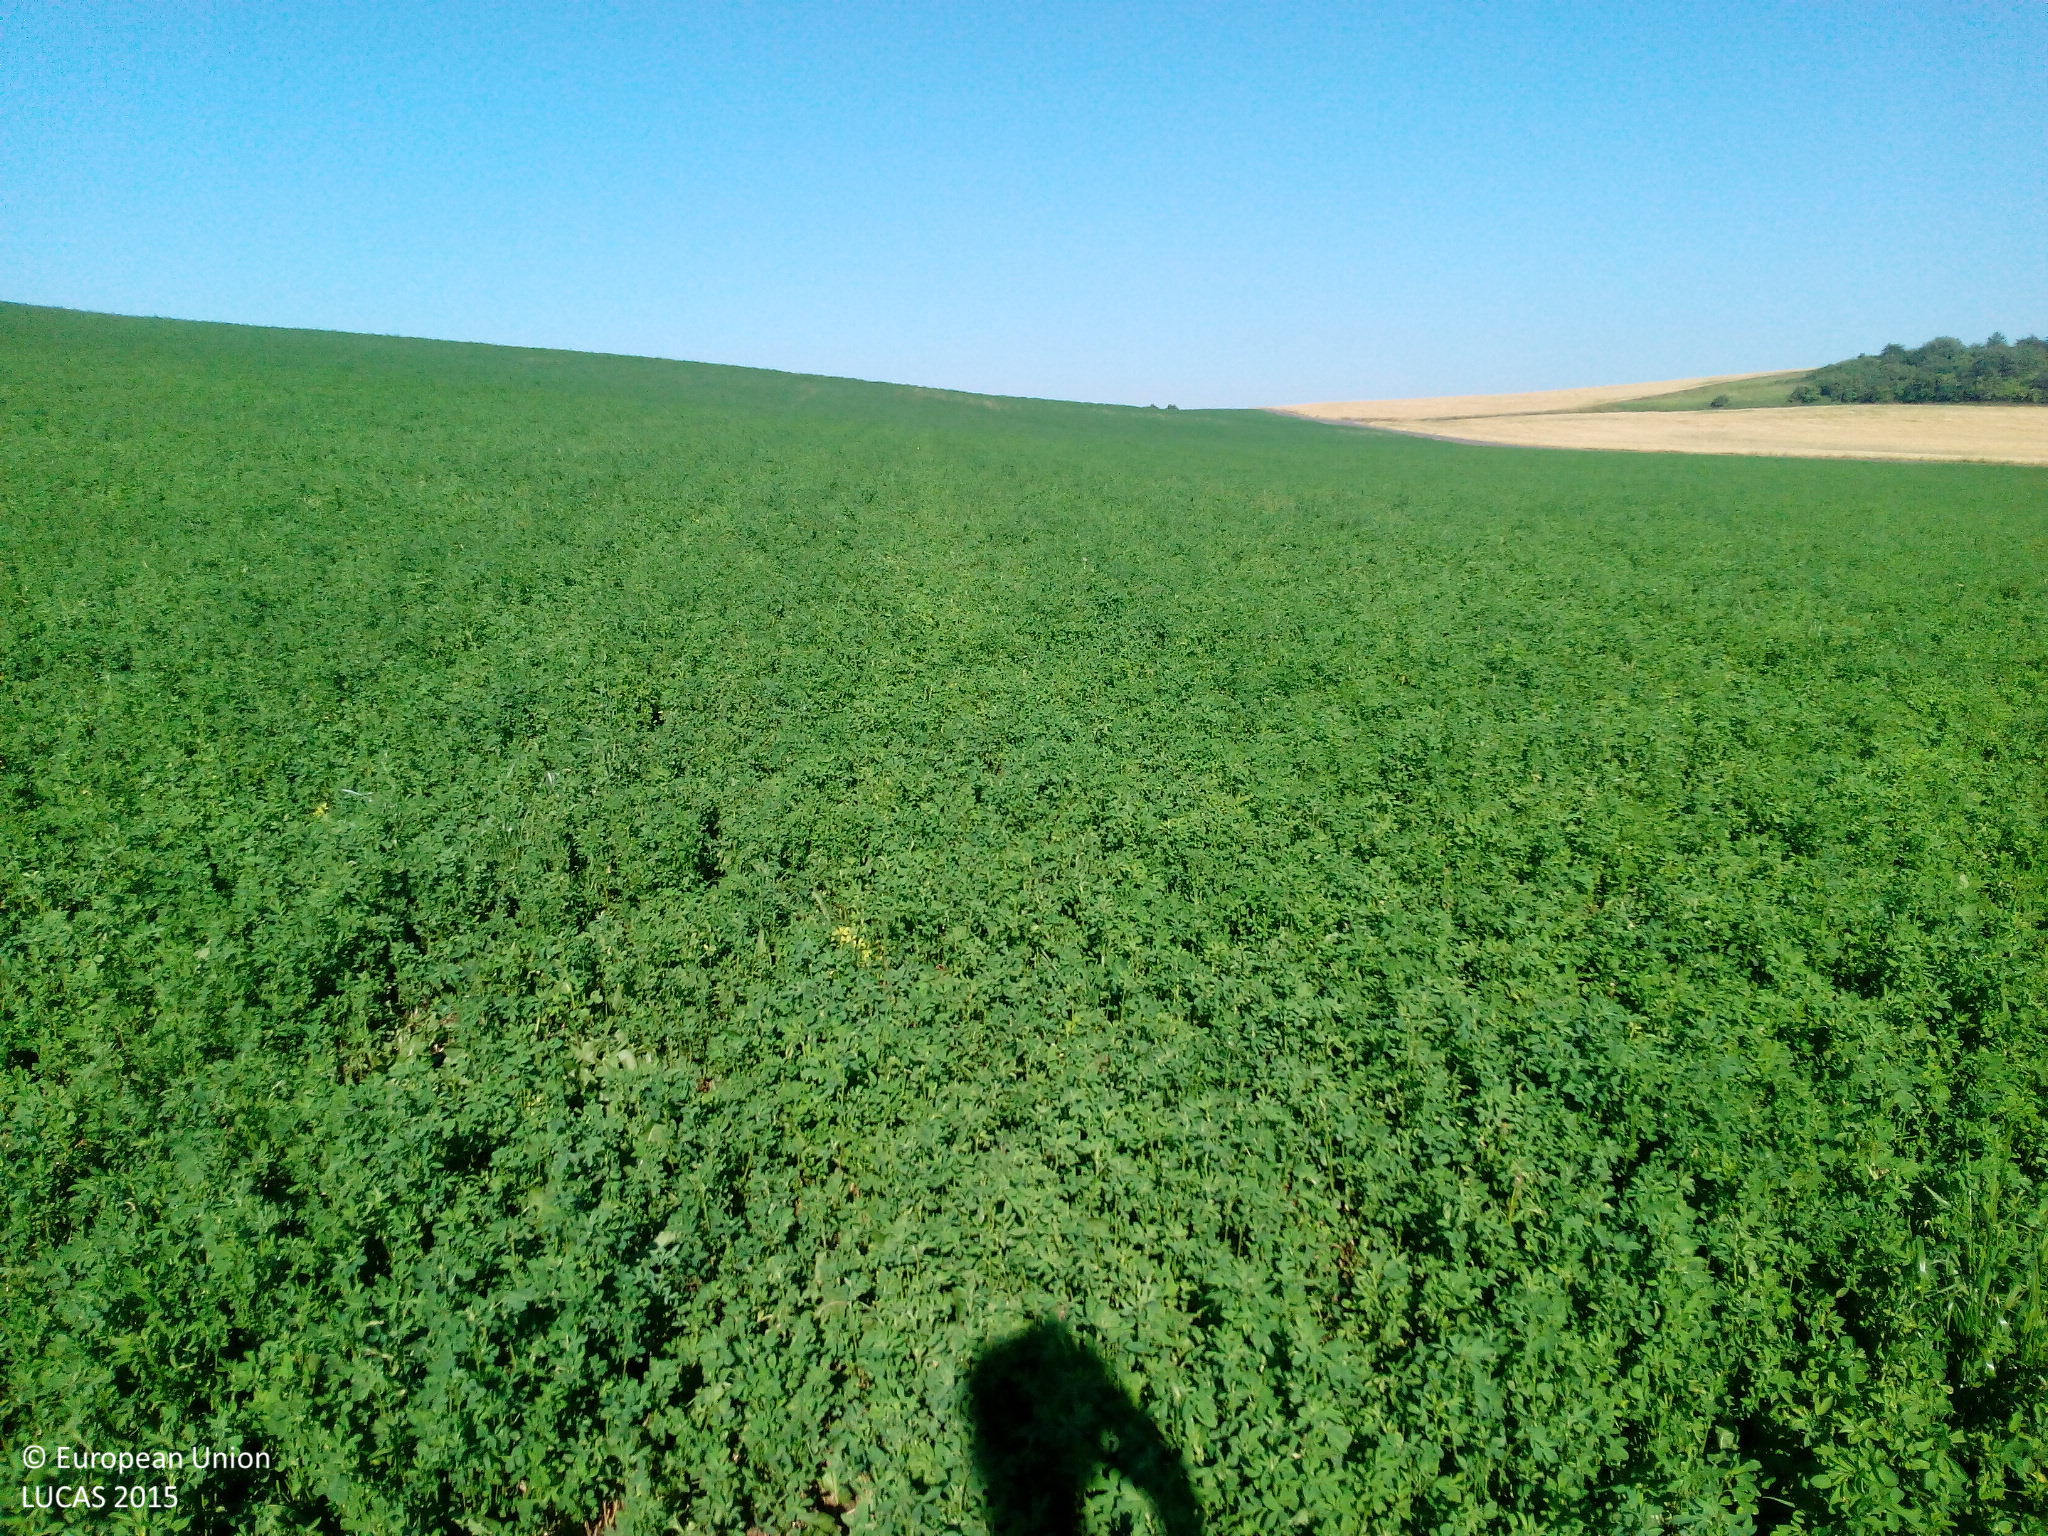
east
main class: Cropland
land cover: Lucerne
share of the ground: > 75 %
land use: Agriculture (excluding fallow land and kitchen gardens)
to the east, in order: Lucerne; Temporary grasslands
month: July
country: DE
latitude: 50.2904
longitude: 10.6314
